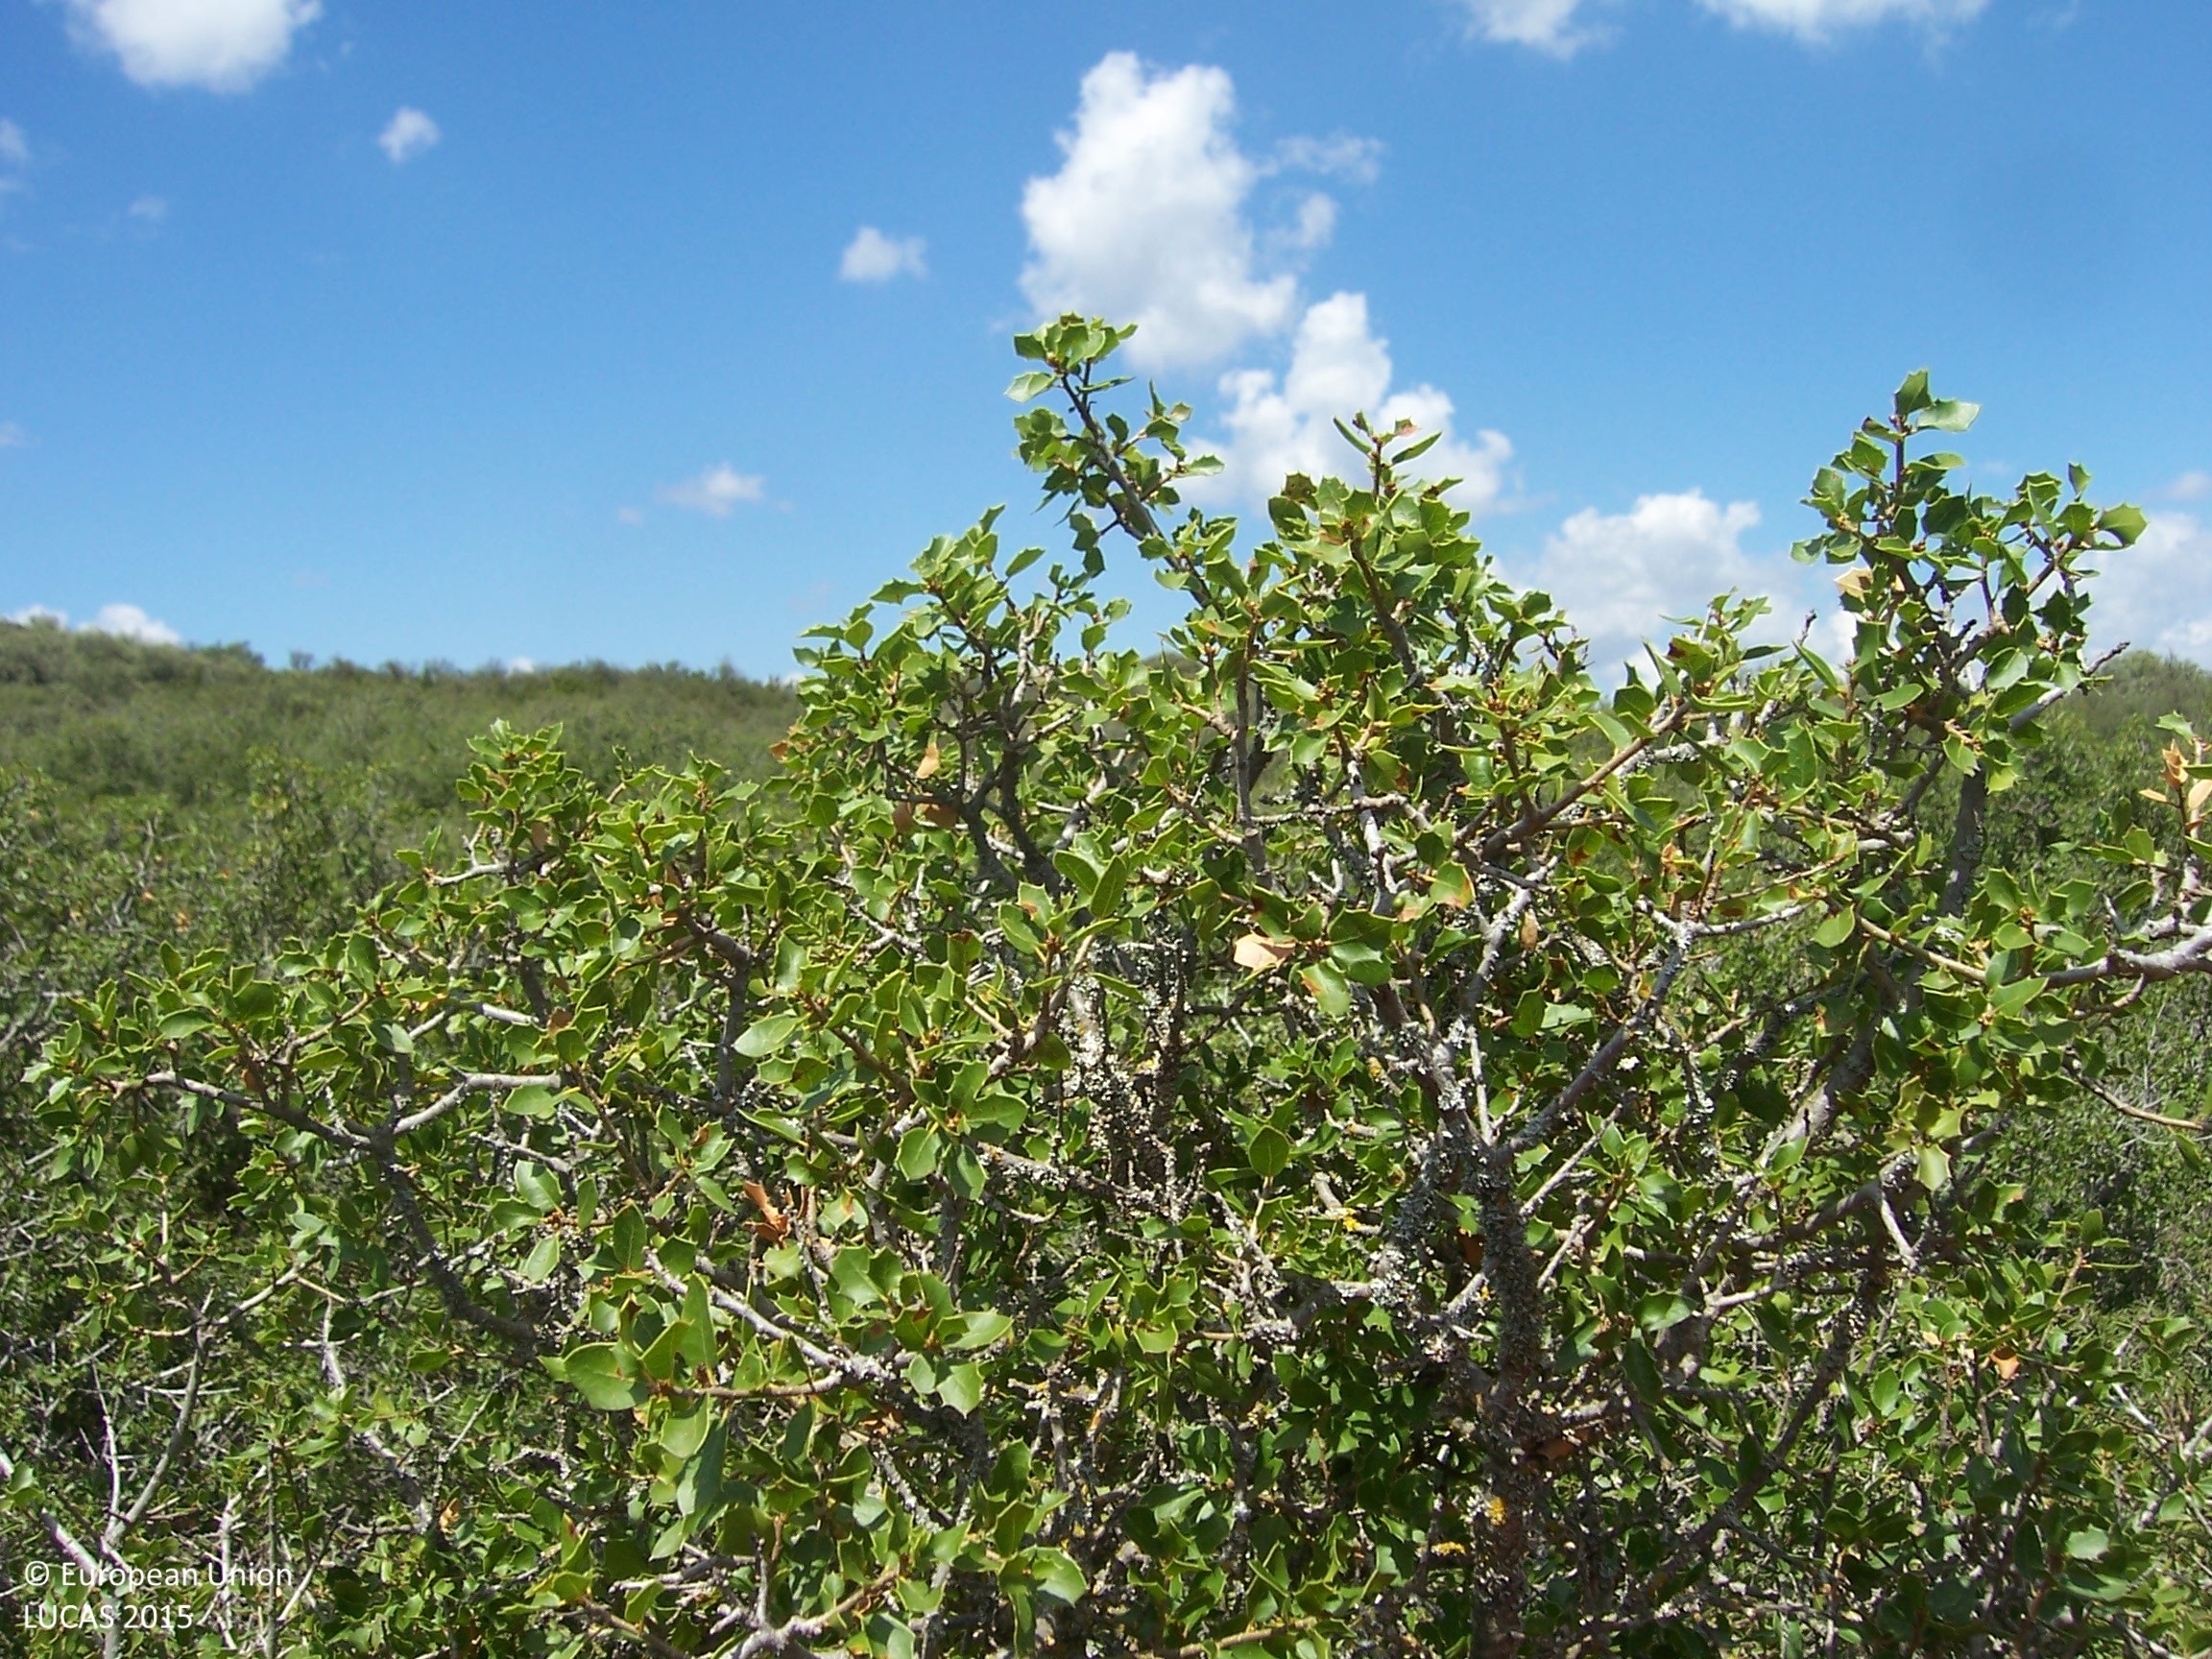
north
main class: Shrubland
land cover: Shrubland without tree cover
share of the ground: > 75 %
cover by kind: shrubs 85 %, unconsolidated bare surface 15 %
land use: Semi-natural and natural areas not in use
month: August
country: ES
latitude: 41.9737
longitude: 0.5354
